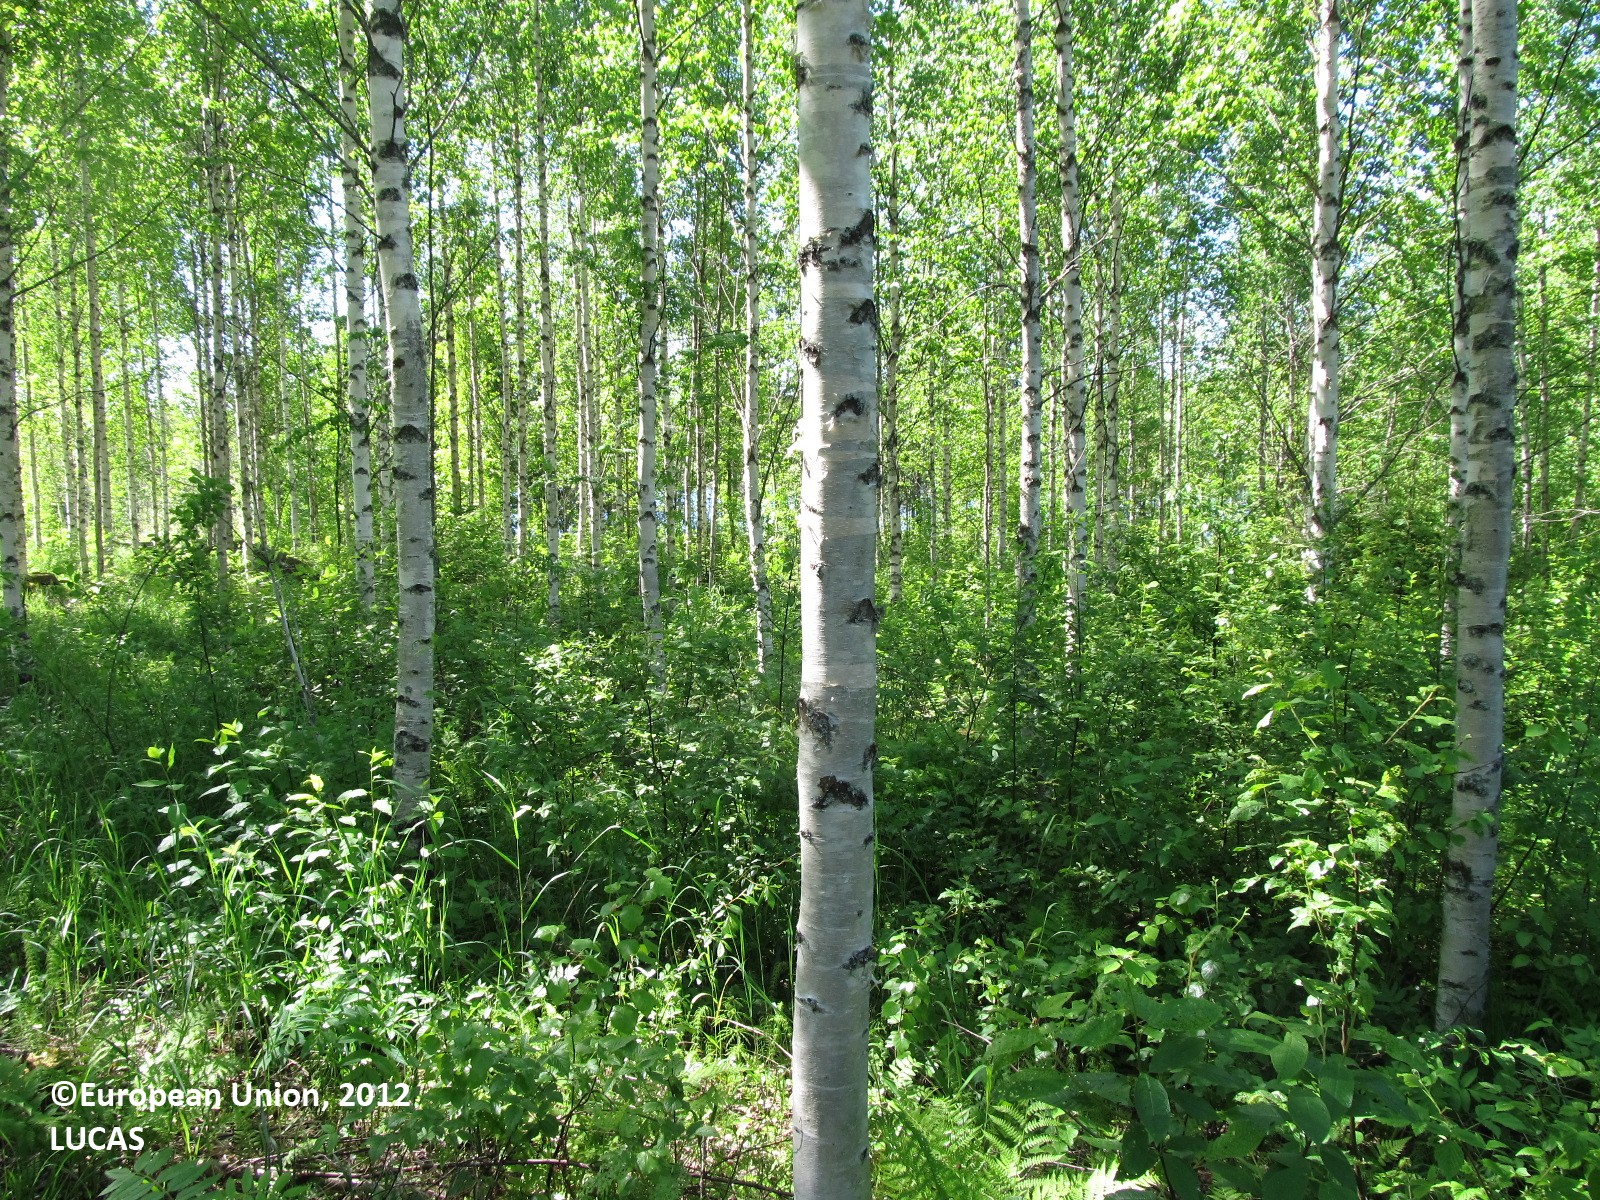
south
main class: Woodland
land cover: Broadleaved woodland
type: boreal forest
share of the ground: 50 - 75 %
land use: Forestry
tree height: > 5 m
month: June
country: FI
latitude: 62.6761
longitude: 27.4457
